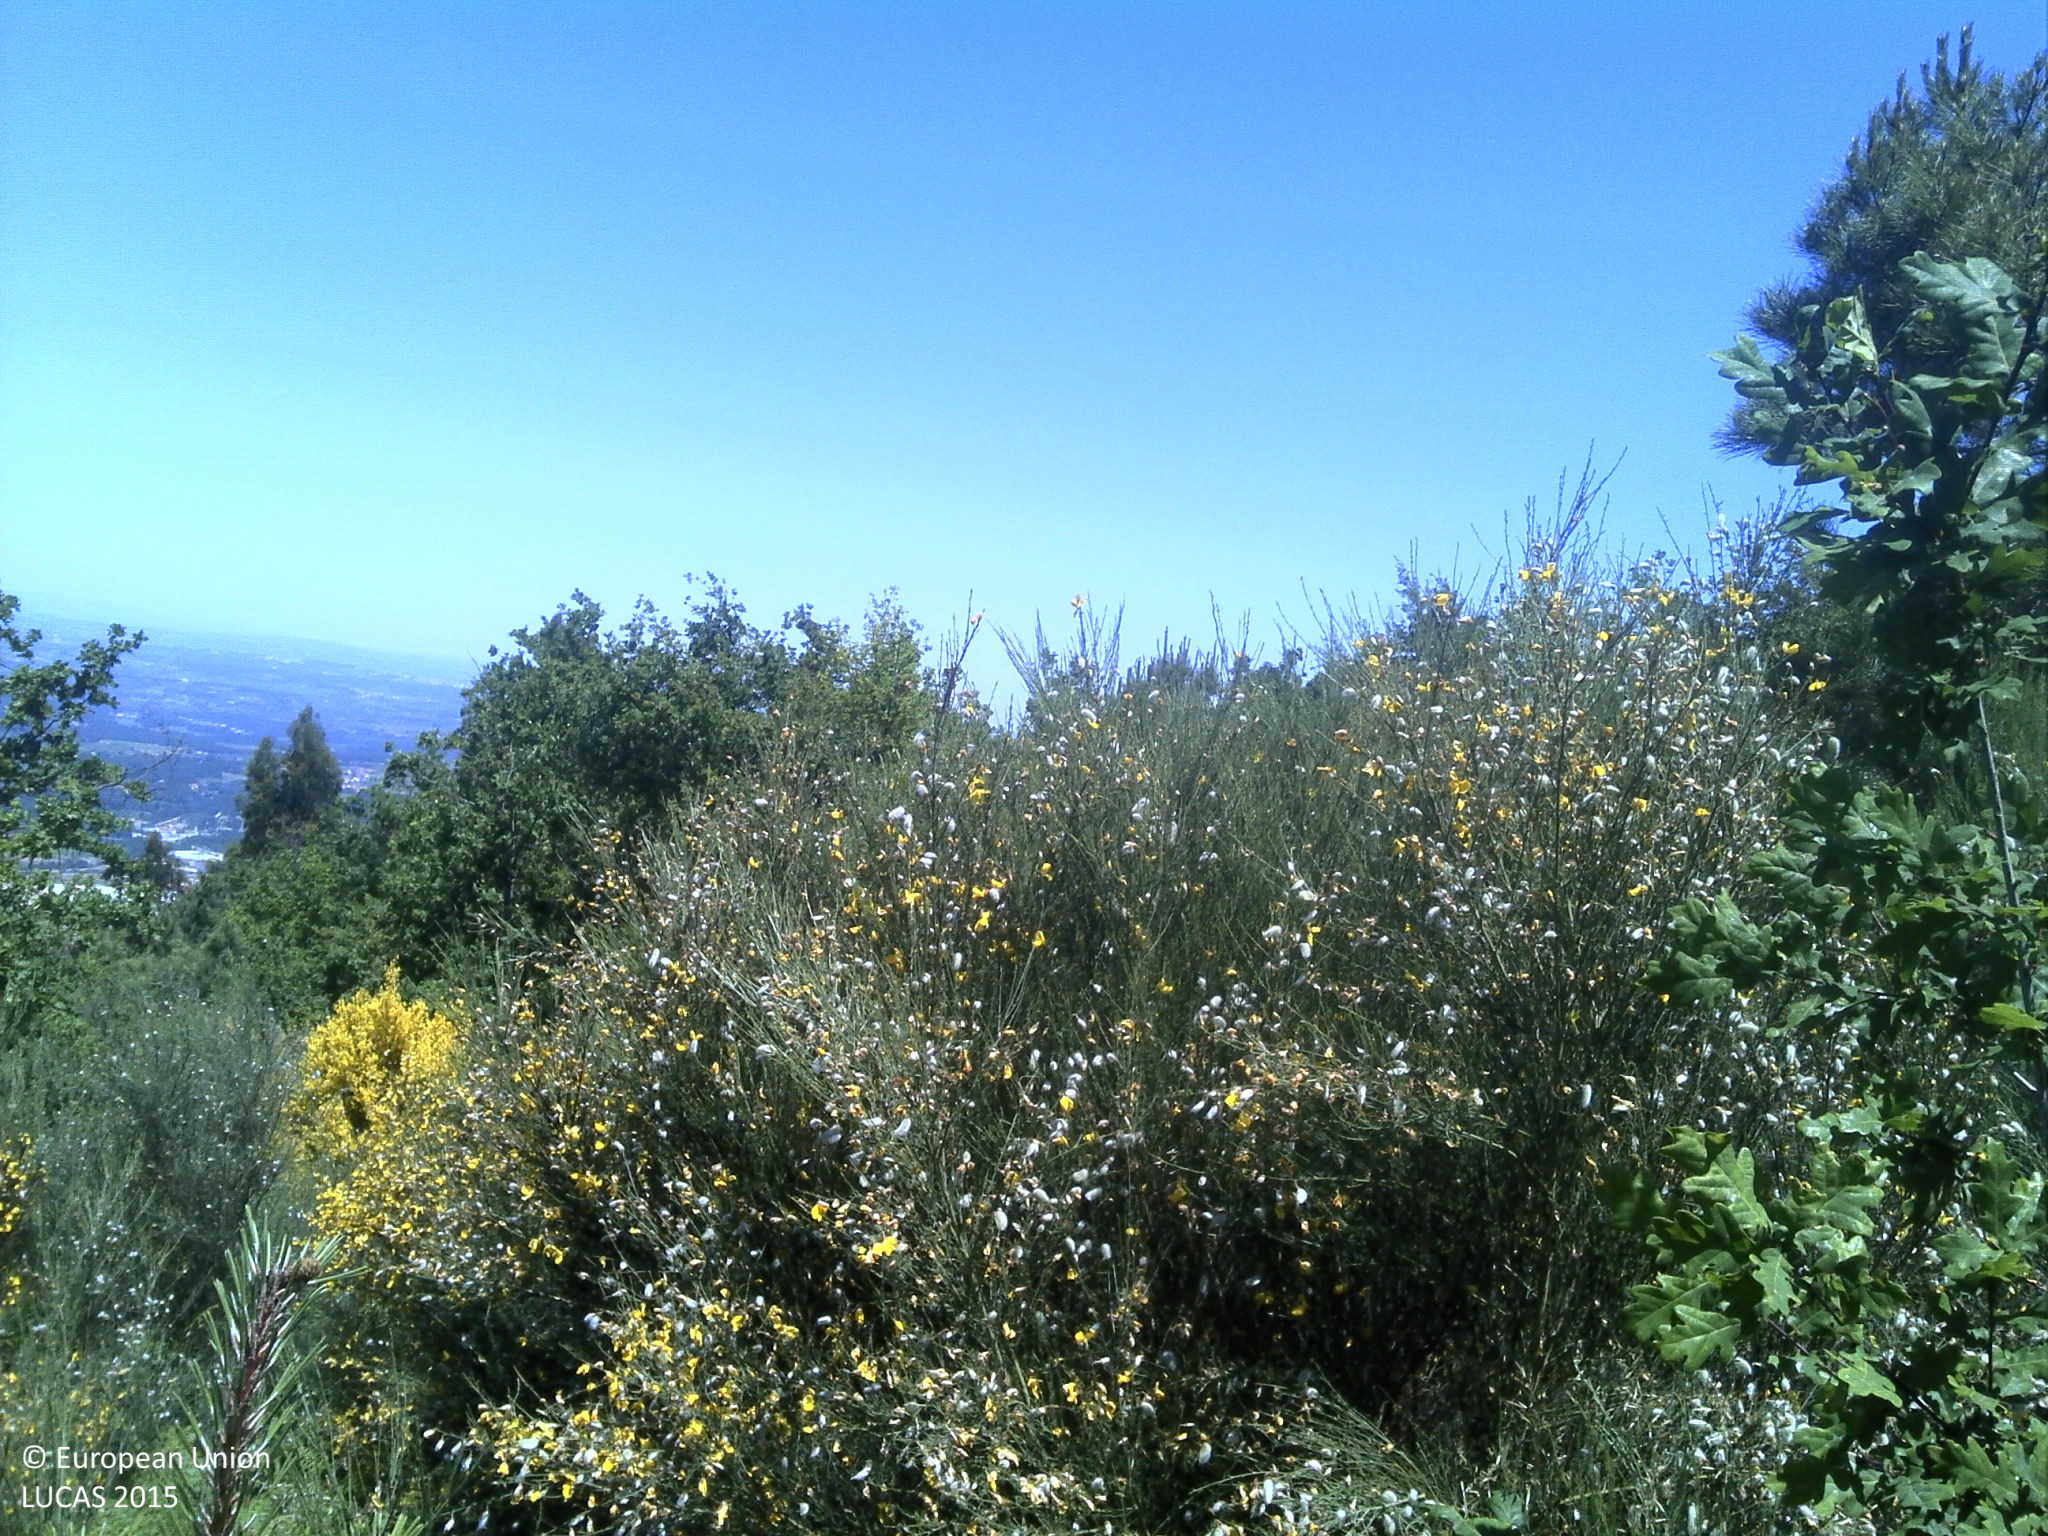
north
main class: Woodland
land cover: Pine dominated coniferous woodland
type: coniferous forest of the mediterranean region
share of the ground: 10 - 25 %
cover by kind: shrubs 60 %, coniferous forest trees 25 %, unconsolidated bare surface 15 %
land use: Forestry
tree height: > 5 m
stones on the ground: 10 - 25 %
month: May
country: PT
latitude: 40.3968
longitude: -7.7046
